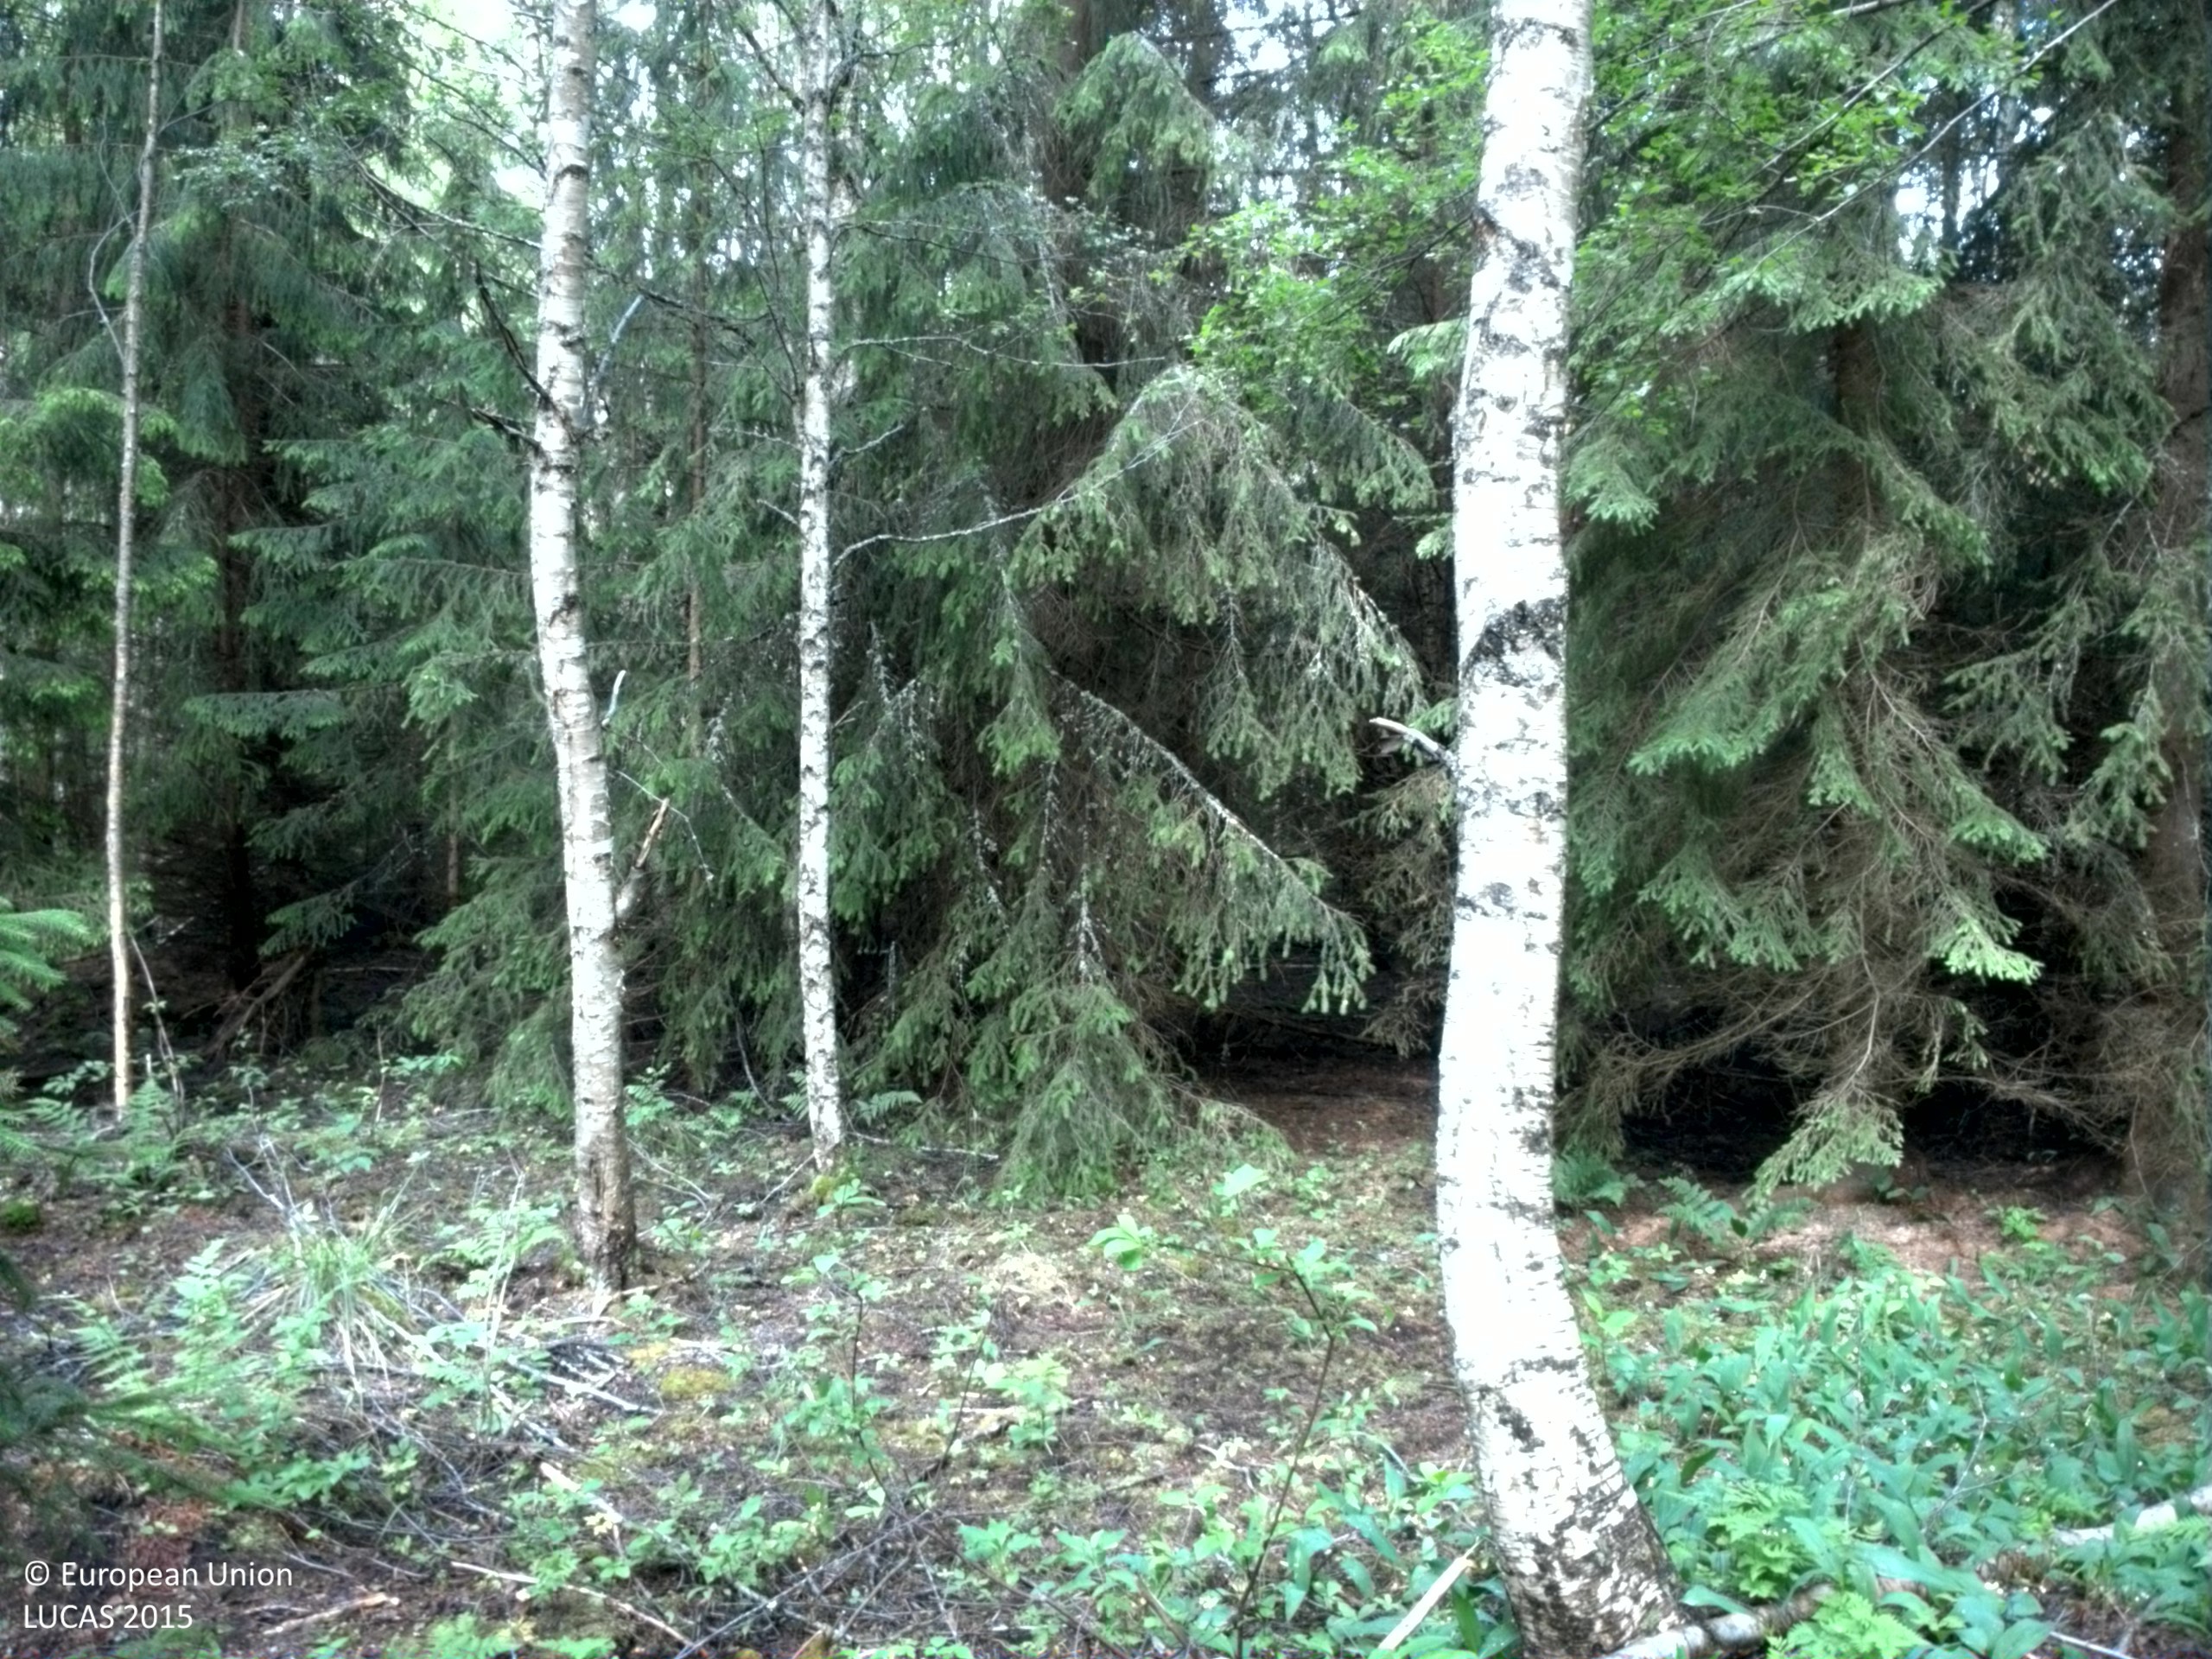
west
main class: Woodland
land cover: Broadleaved woodland
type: boreal forest
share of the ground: 50 - 75 %
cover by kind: broadleaved forest trees 65 %, herbaceous plants 20 %, coniferous forest trees 5 %, lichens and mosses 5 %
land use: Forestry
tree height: > 5 m
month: June
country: SE
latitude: 60.3346
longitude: 17.6542
